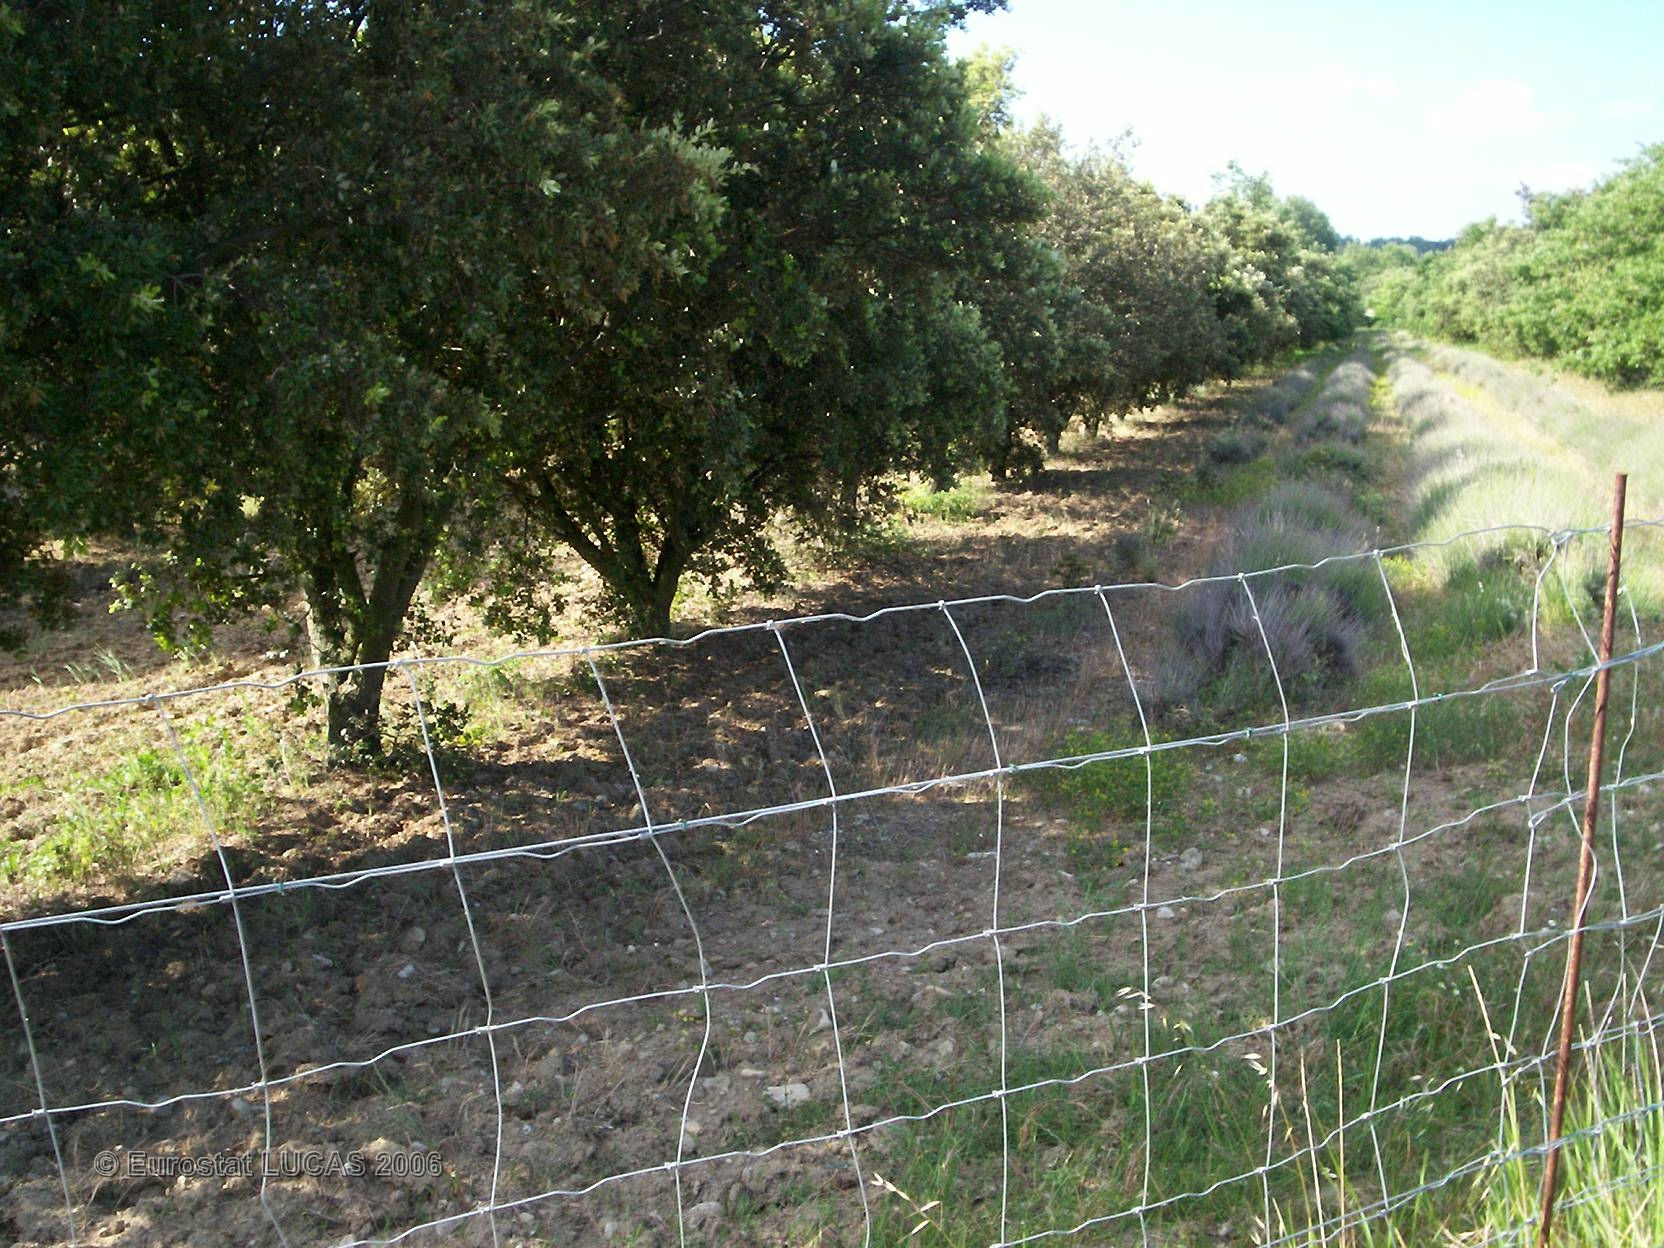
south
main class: Woodland
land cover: Broadleaved forest
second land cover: Permanent industrial crops
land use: Agriculture (excluding fallow land and kitchen gardens)
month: June
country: FR
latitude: 44.4249
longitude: 4.9200
